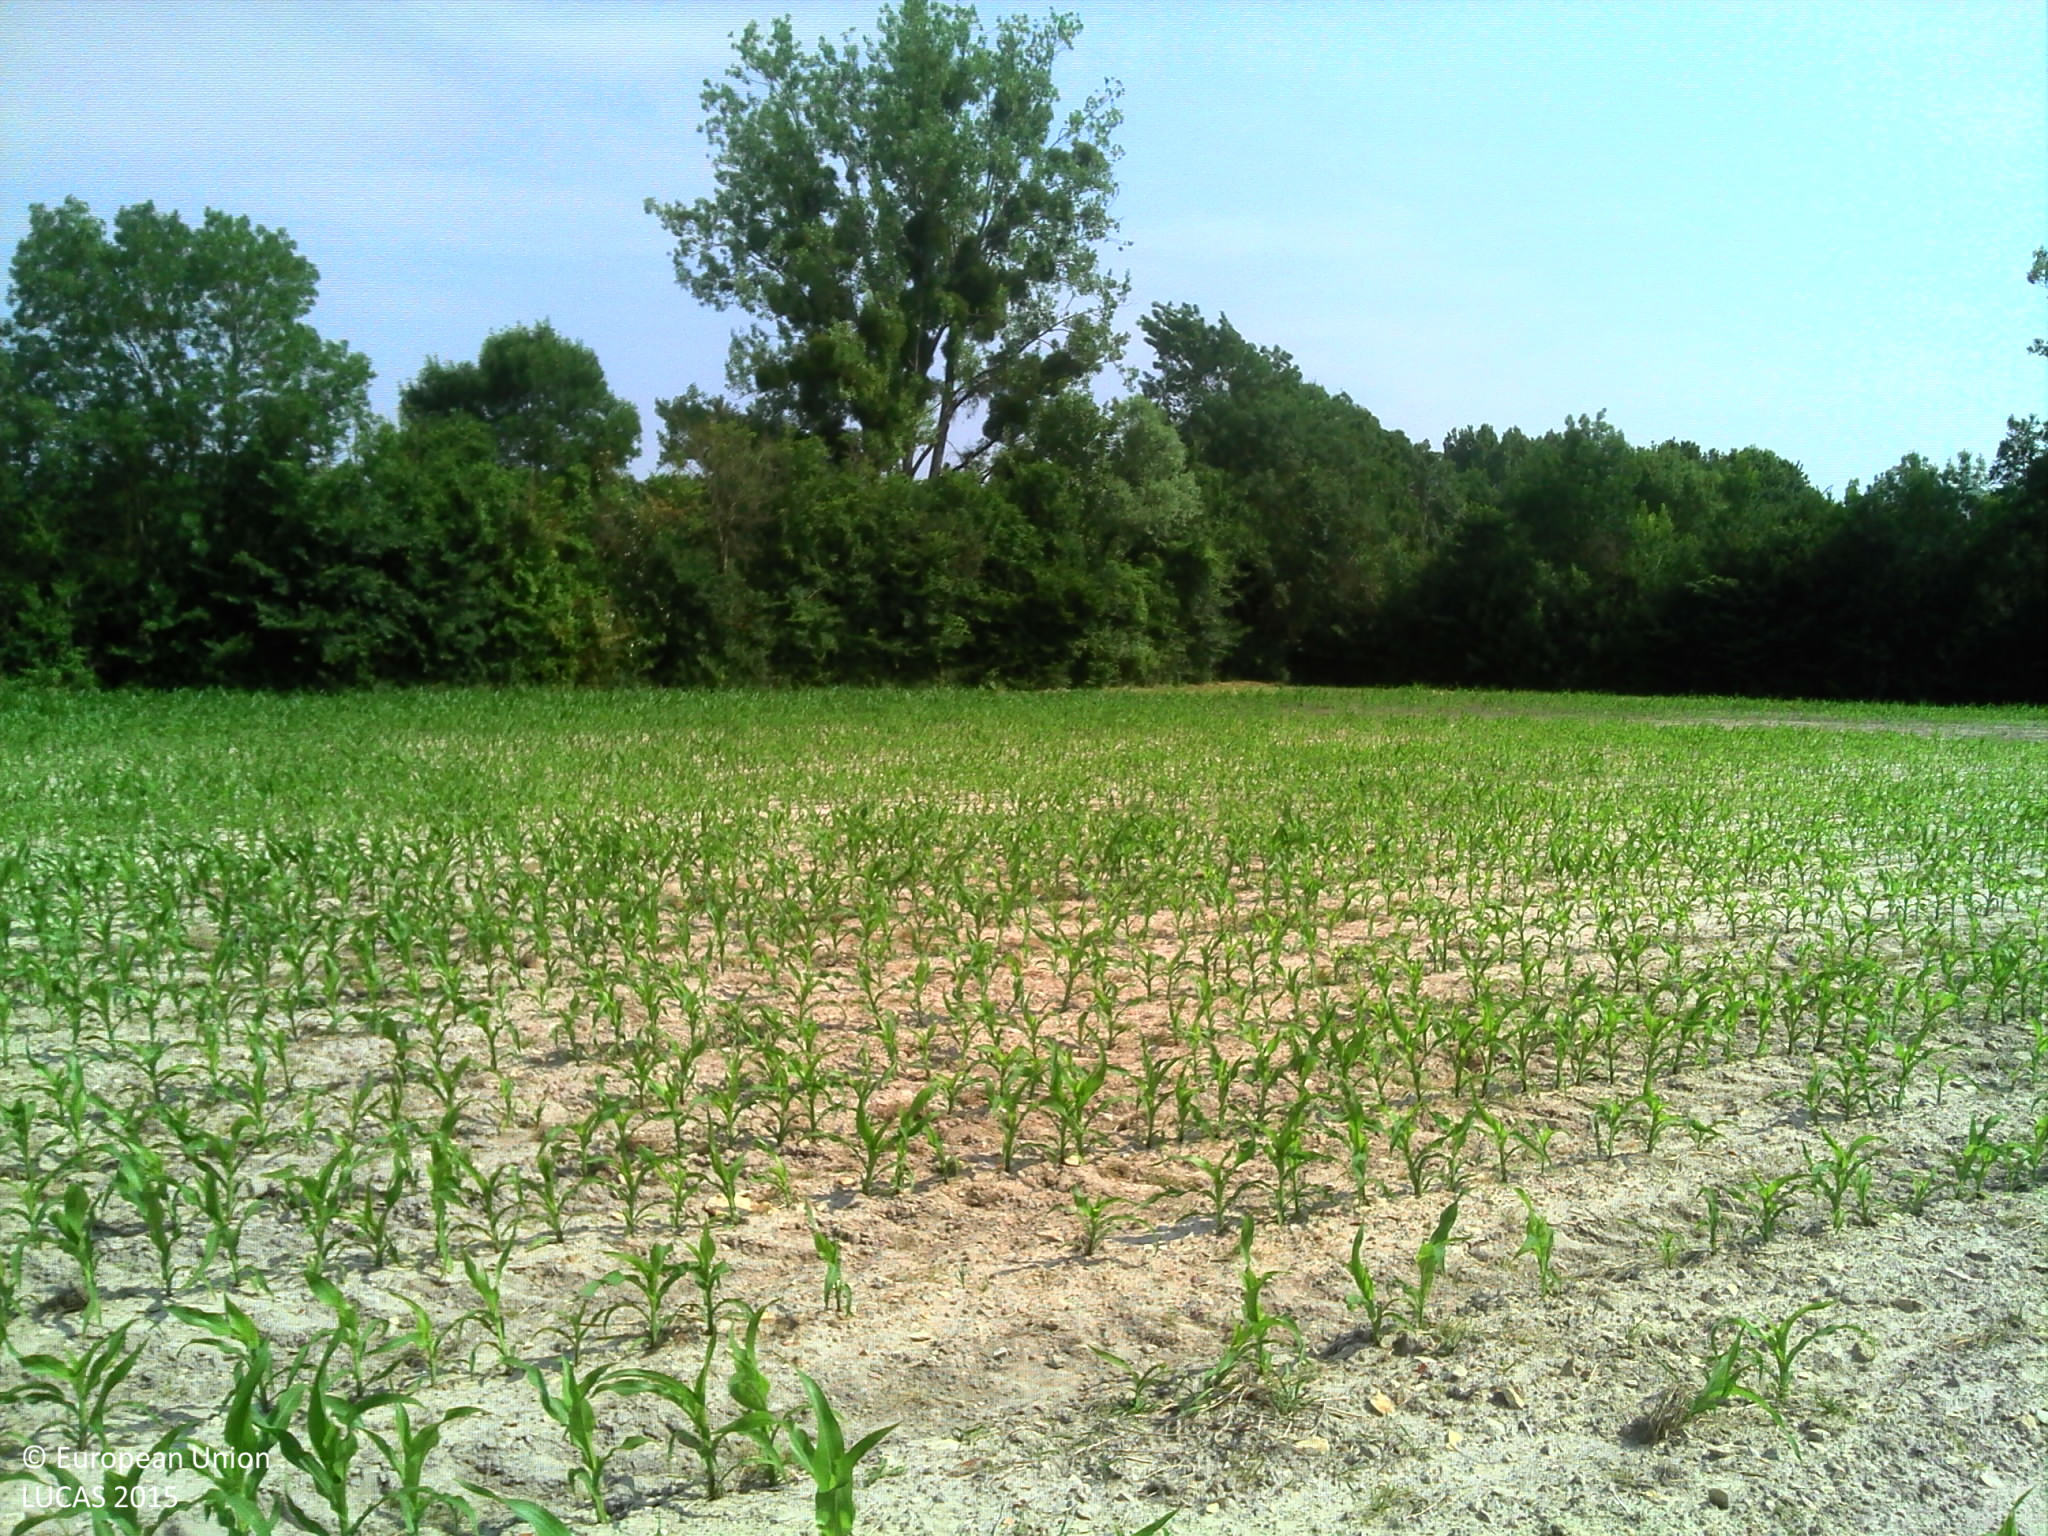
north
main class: Cropland
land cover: Maize
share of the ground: 10 - 25 %
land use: Agriculture (excluding fallow land and kitchen gardens)
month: June
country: FR
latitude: 47.5950
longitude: 0.0933
